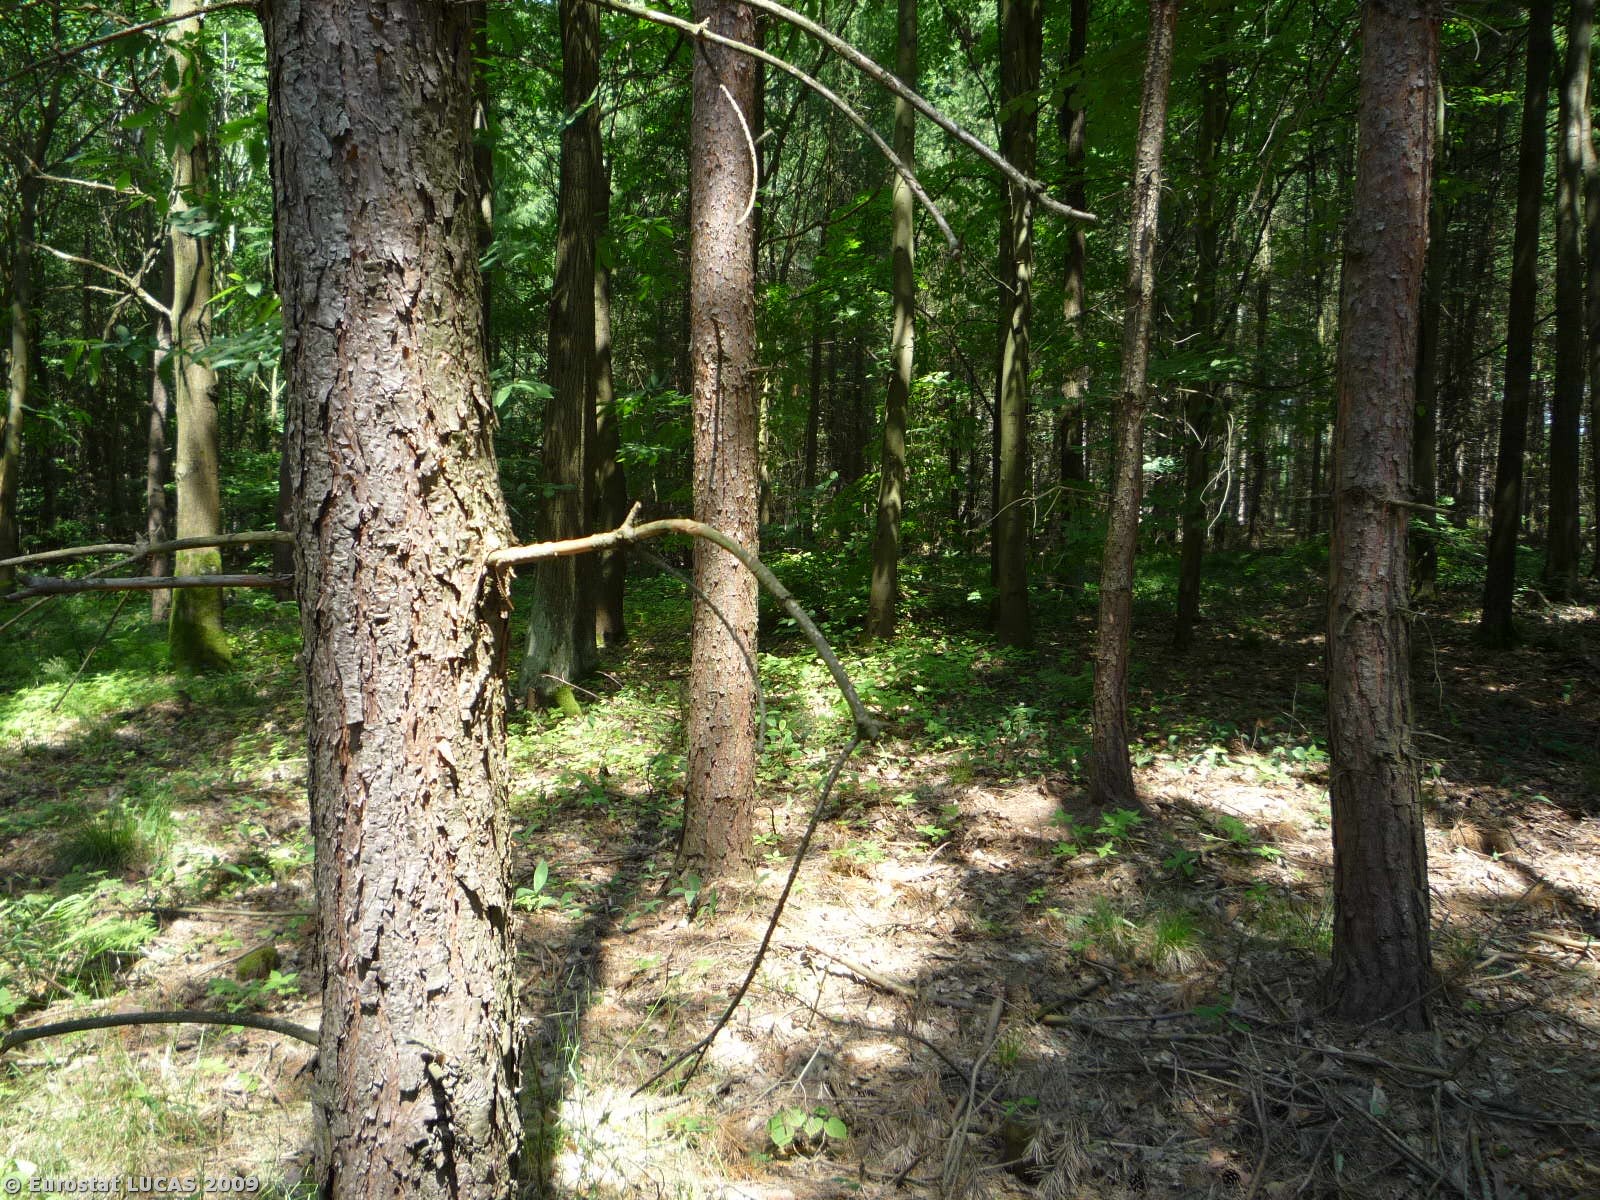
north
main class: Woodland
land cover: Coniferous woodland
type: hemiboreal forest and nemoral coniferous forest and mixed broadleaved-coniferous forest
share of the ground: > 75 %
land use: Forestry
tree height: > 5 m
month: June
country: CZ
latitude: 49.9802
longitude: 15.4845
